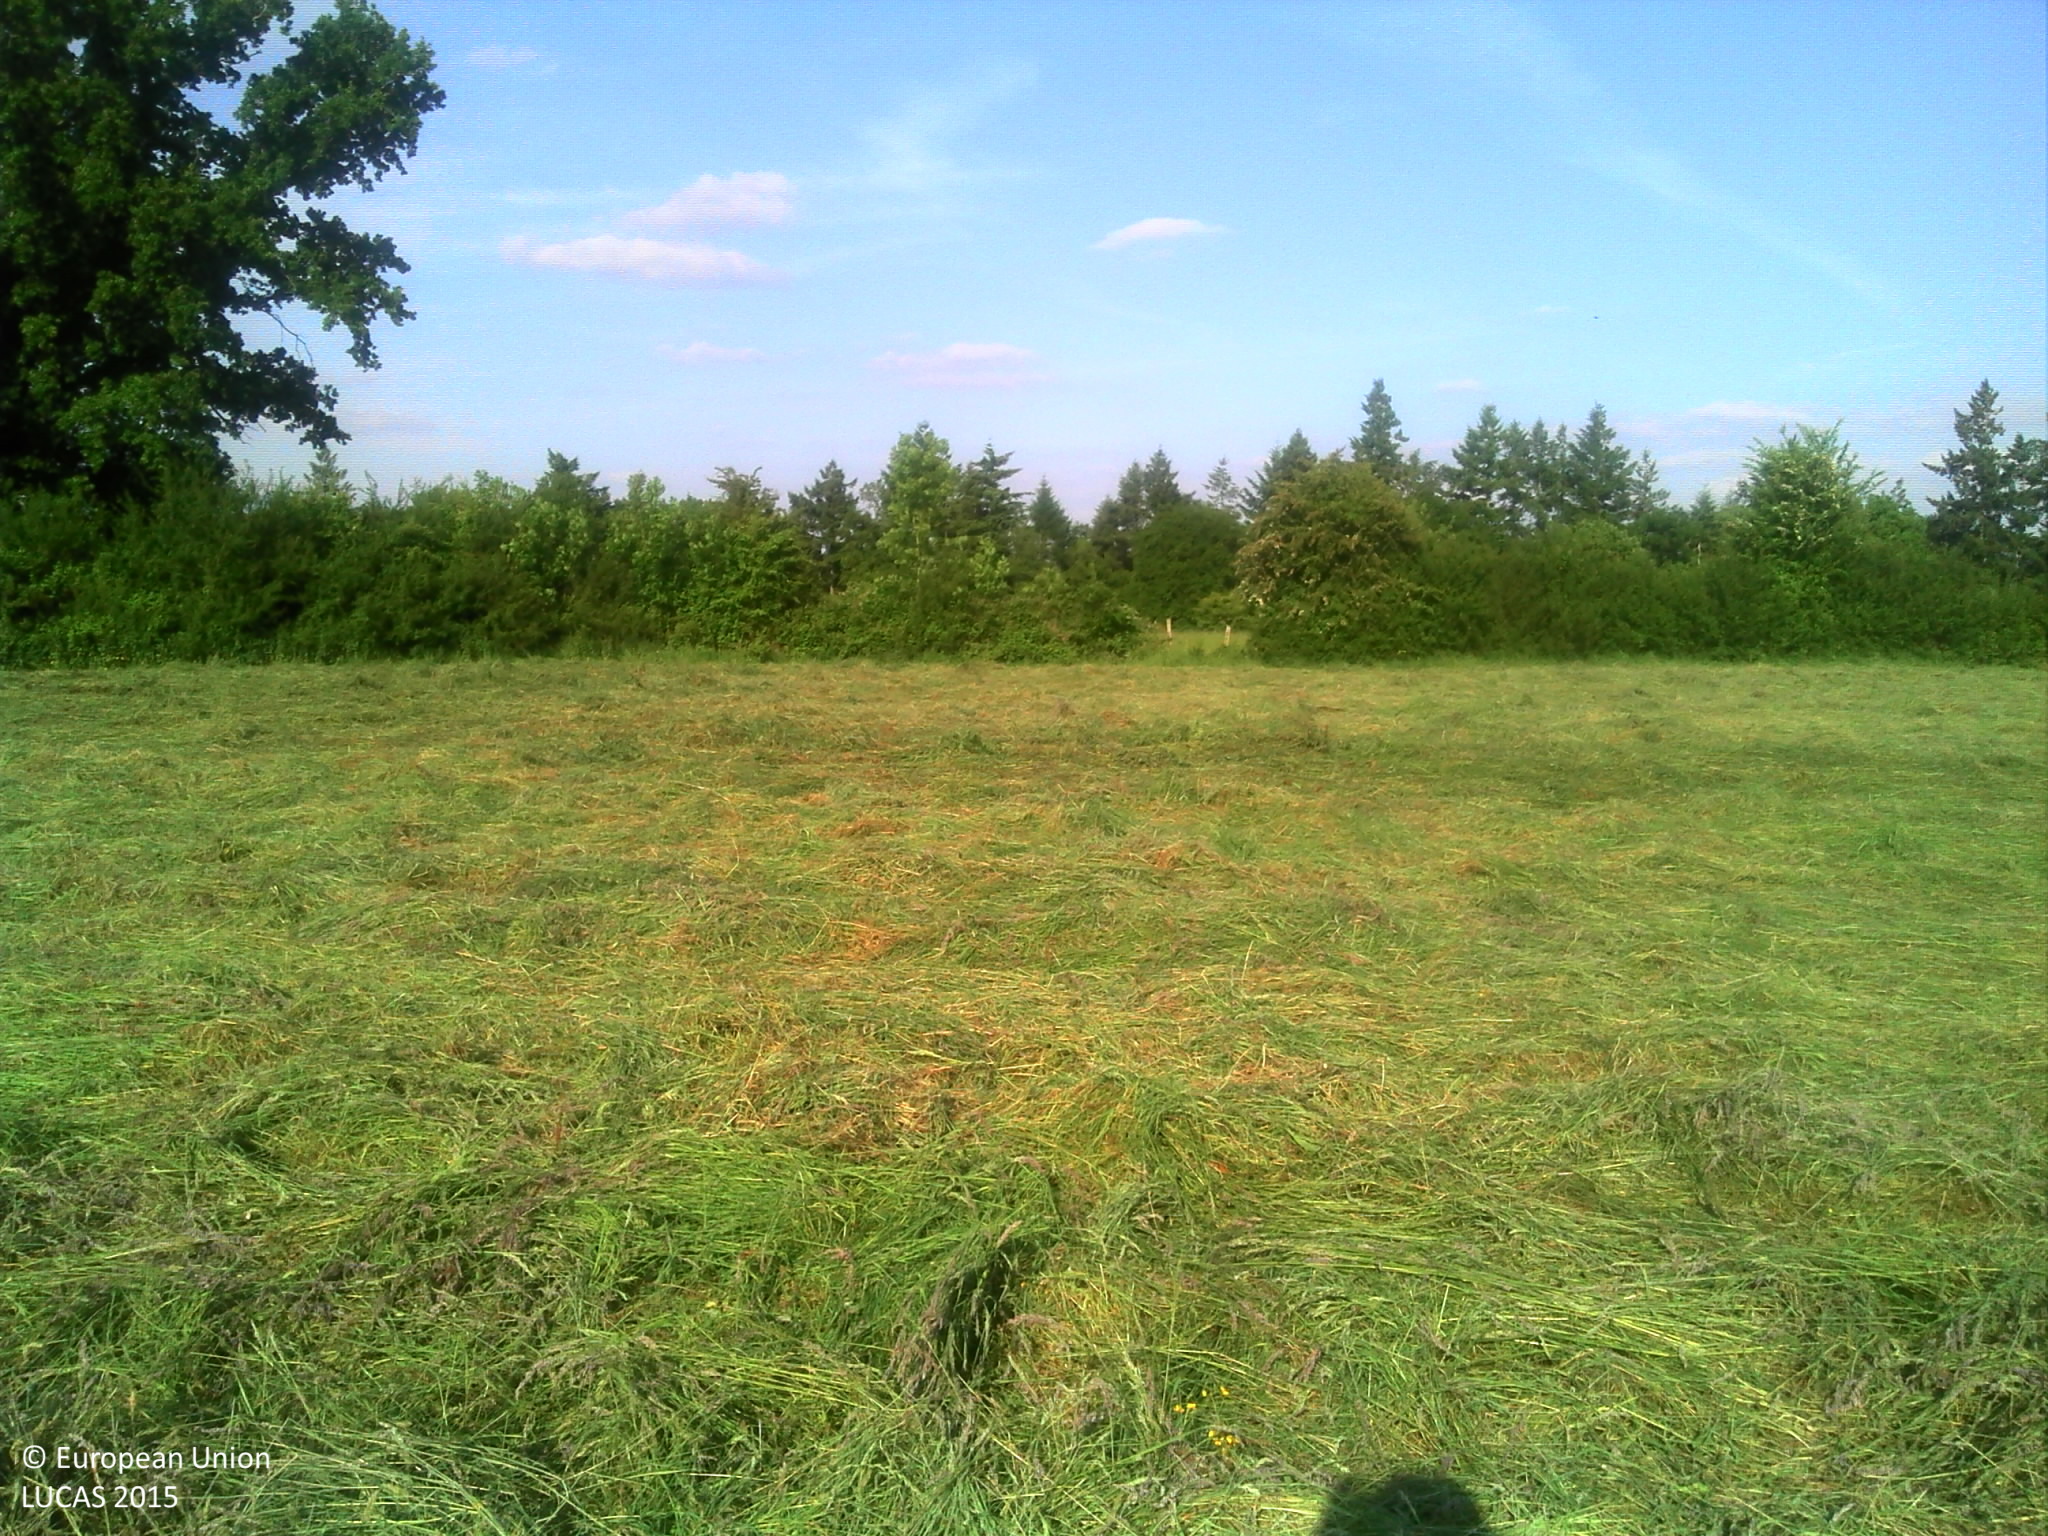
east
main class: Cropland
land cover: Mixed cereals for fodder
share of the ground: > 75 %
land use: Agriculture (excluding fallow land and kitchen gardens)
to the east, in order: Mixed cereals for fodder; Lines of trees; Fences; Grassland with sparse tree/shrub cover; Fences; Spontaneously vegetated surfaces; Fences; Broadleaved woodland; Tracks; Fences; Other mixed woodland
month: May
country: FR
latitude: 48.6609
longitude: -0.1461
